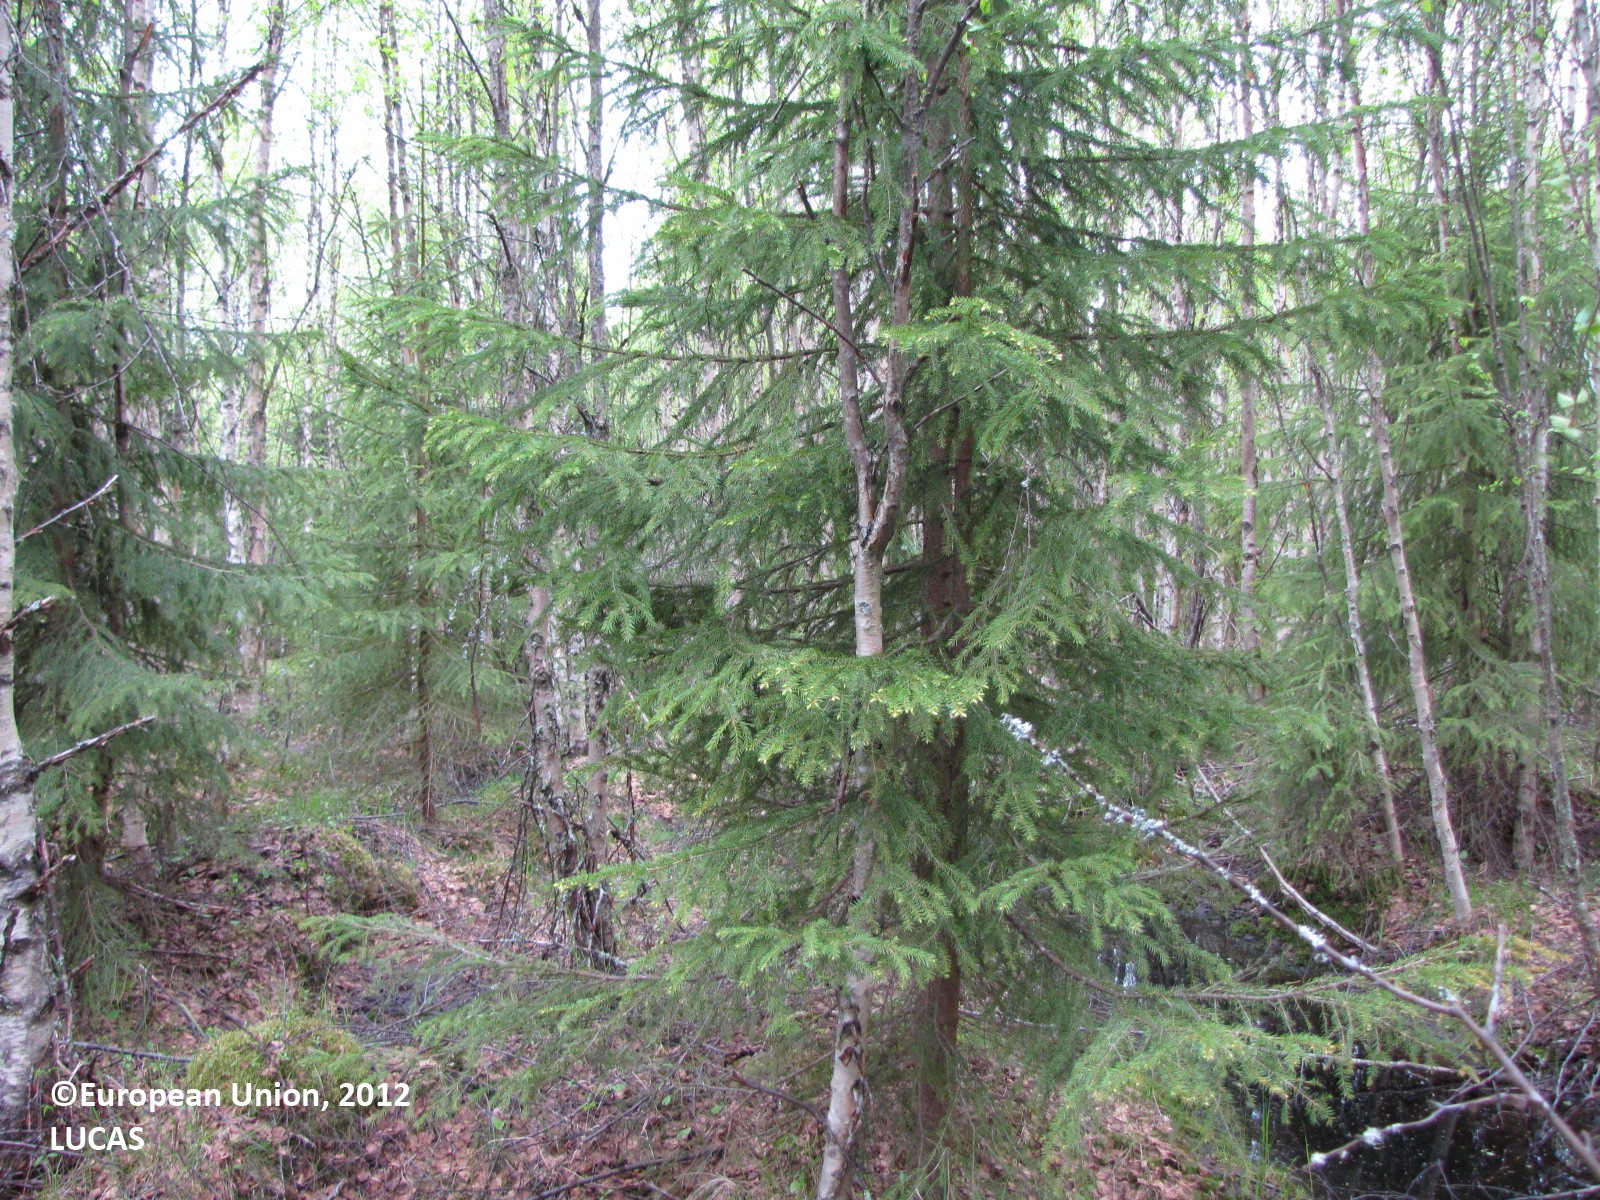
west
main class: Woodland
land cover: Spruce dominated mixed woodland
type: boreal forest
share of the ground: 50 - 75 %
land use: Forestry
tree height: > 5 m
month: June
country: FI
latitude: 65.8462
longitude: 24.5305
